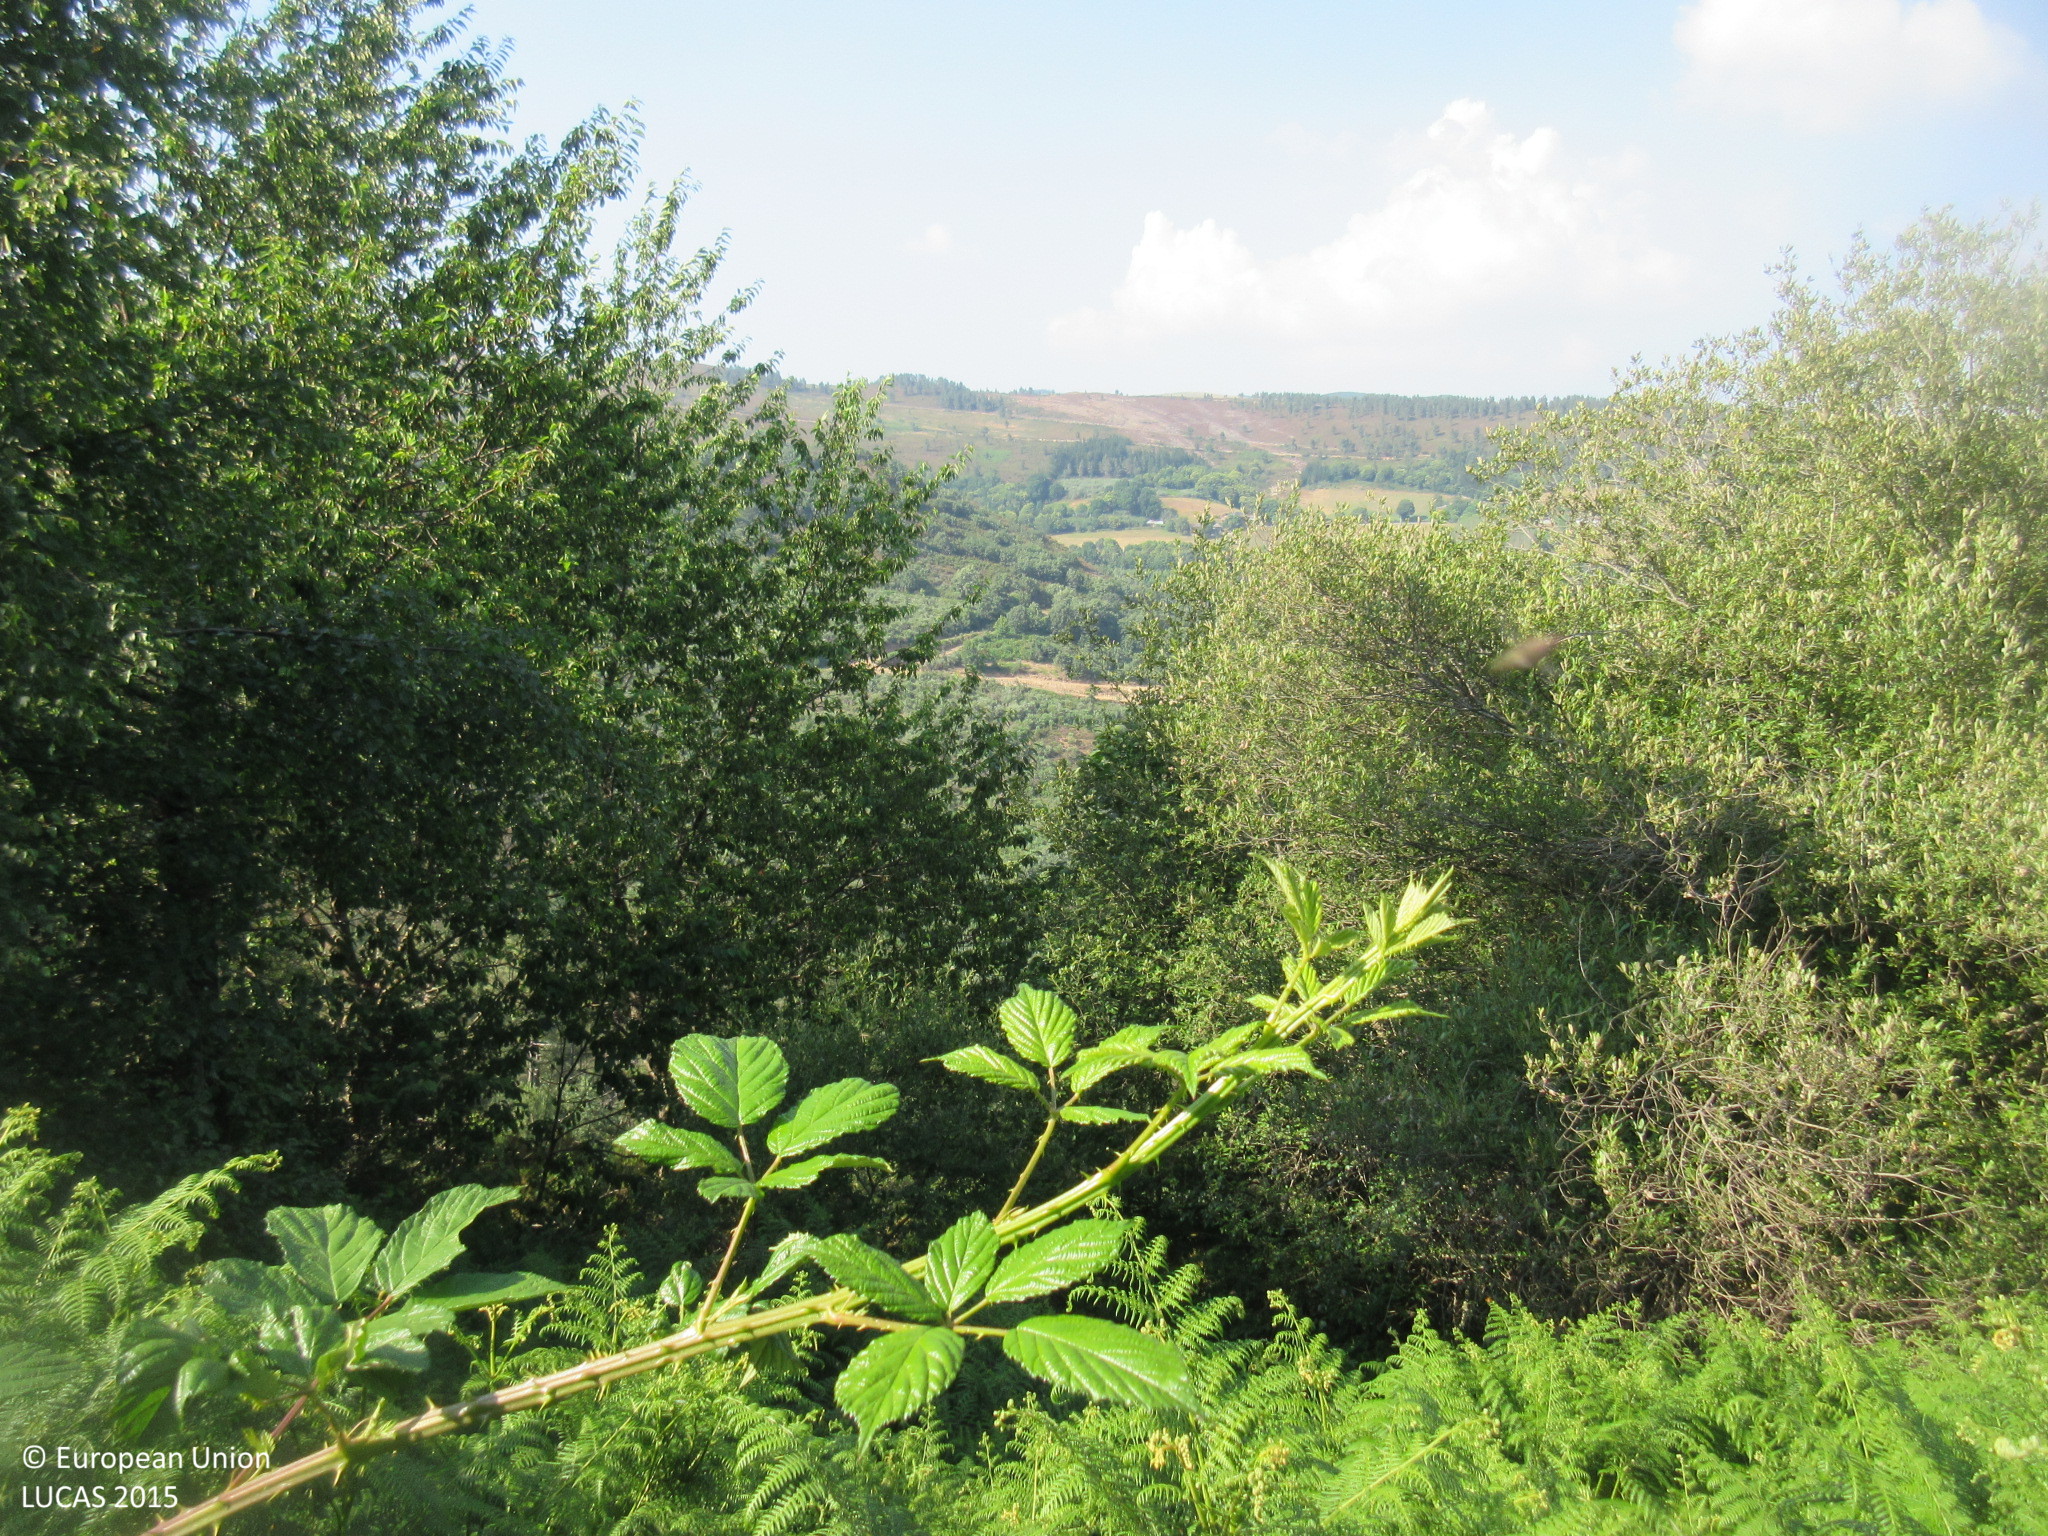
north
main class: Woodland
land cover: Broadleaved woodland
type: acidophilous oak and oak-birch forest
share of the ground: > 75 %
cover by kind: broadleaved forest trees 75 %, shrubs 25 %
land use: Forestry
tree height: > 5 m
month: June
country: ES
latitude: 42.9823
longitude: -7.0477
